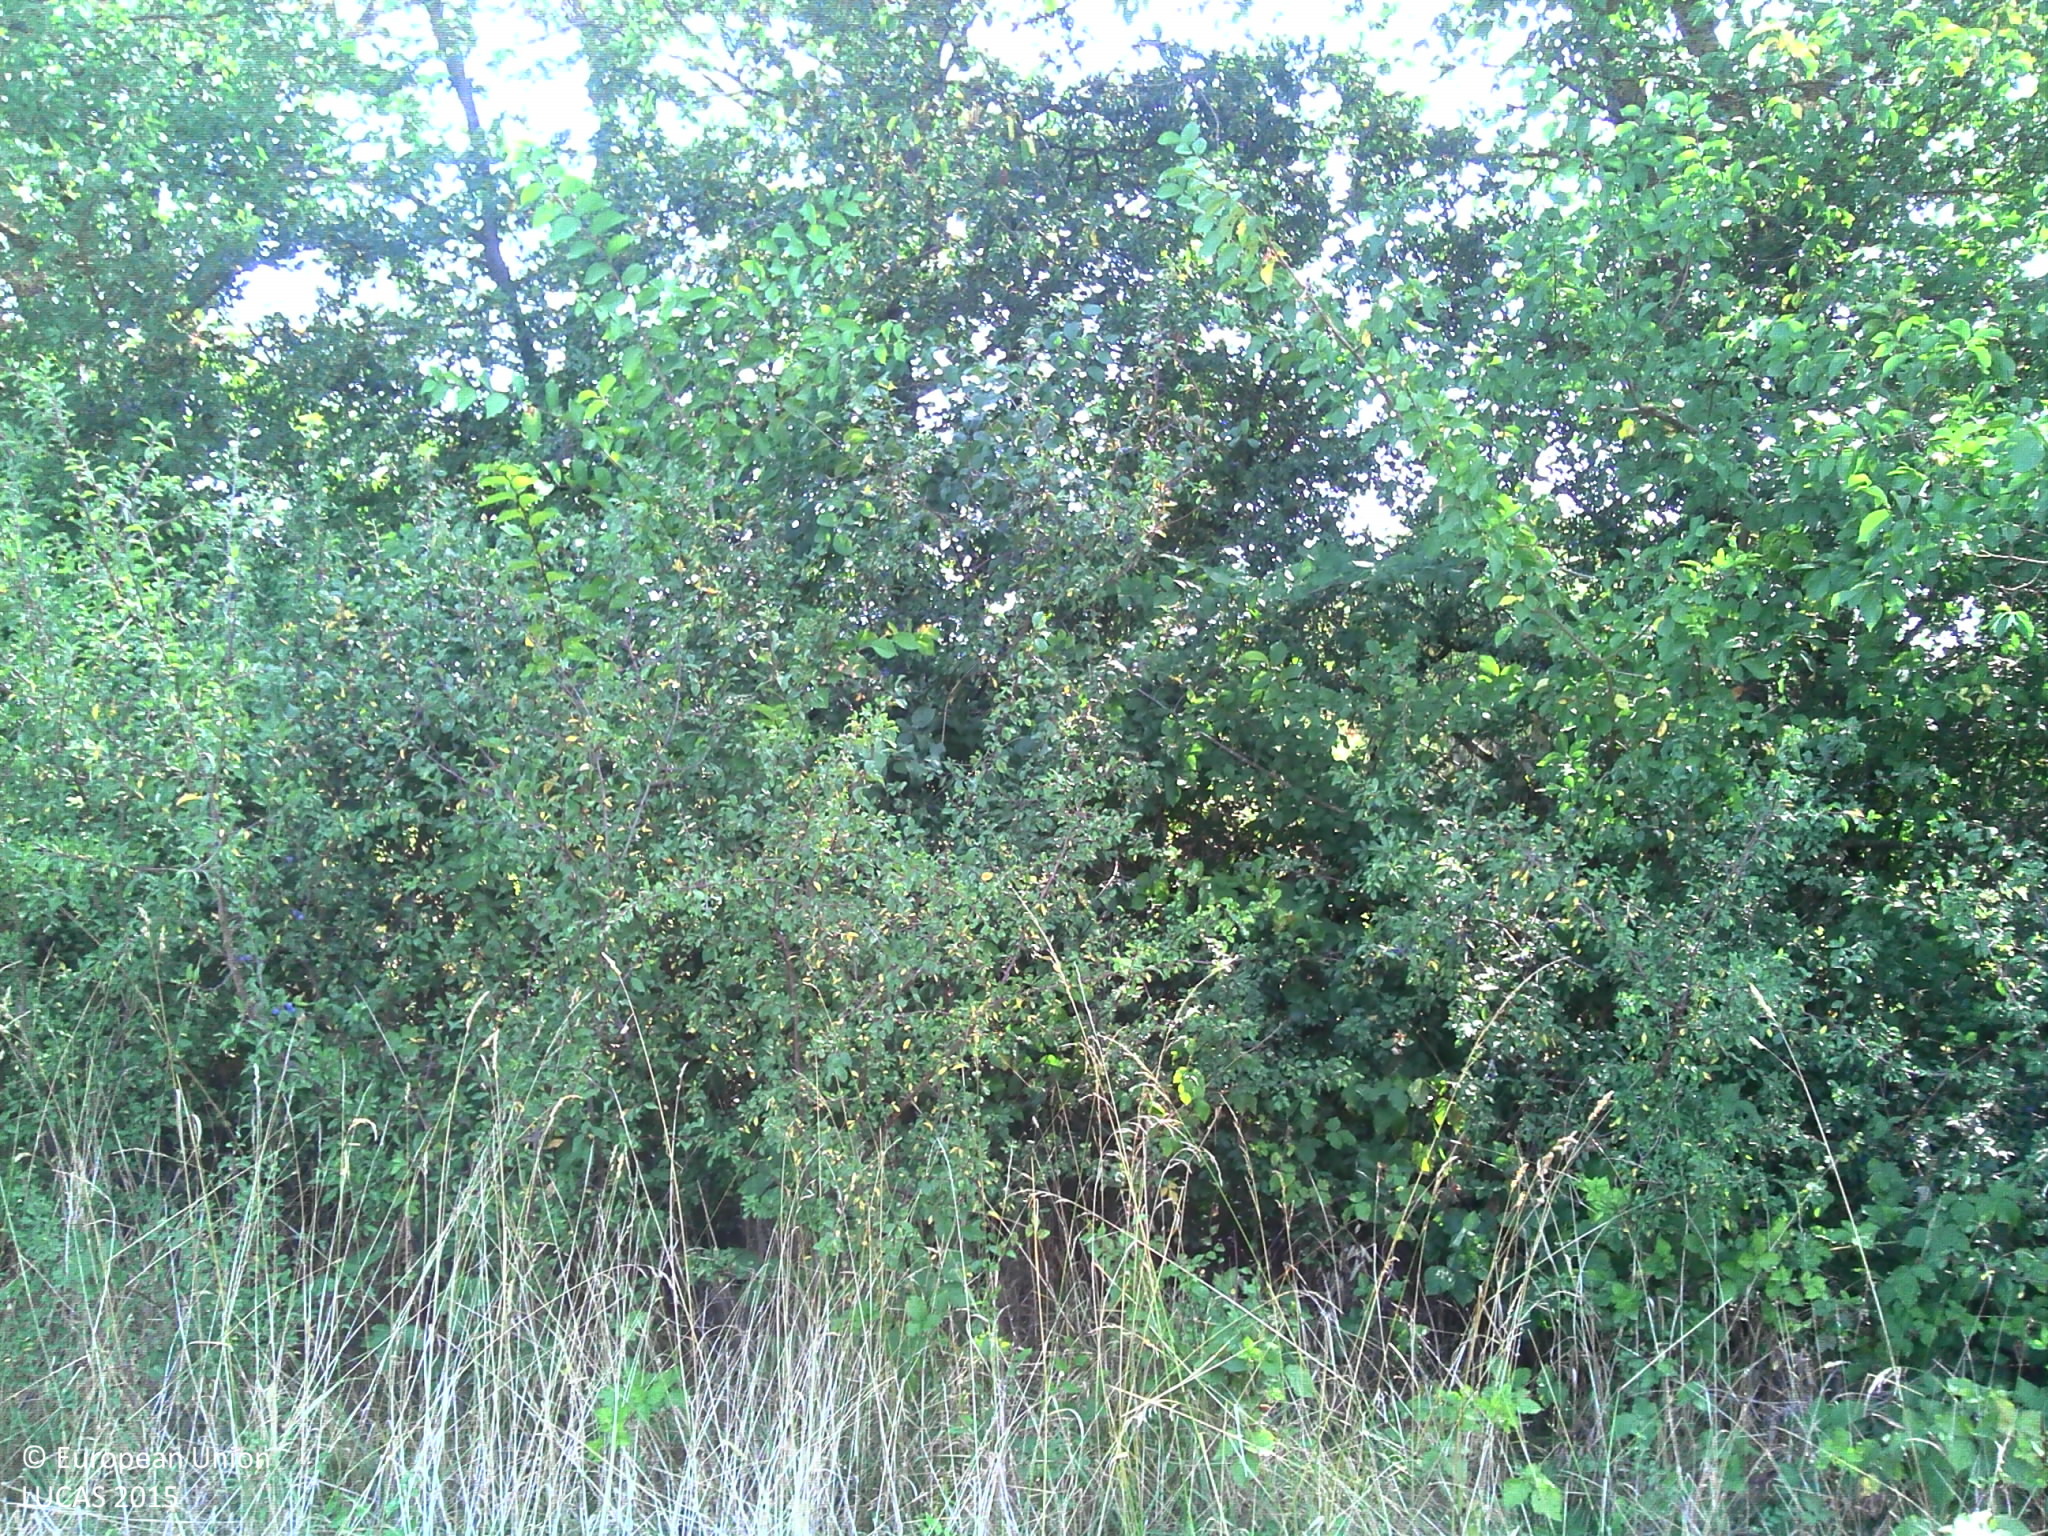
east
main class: Grassland
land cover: Grassland without tree/shrub cover
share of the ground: > 75 %
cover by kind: herbaceous plants 100 %
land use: Agriculture (excluding fallow land and kitchen gardens)
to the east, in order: Grassland without tree/shrub cover; Abandoned hedges; Lucerne; Grass margins; Ditches and canals; Abandoned hedges; Grassland without tree/shrub cover; Grass margins; Tracks; Grass margins; Ditches and canals; Common wheat
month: August
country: FR
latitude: 46.7187
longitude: 2.7345
